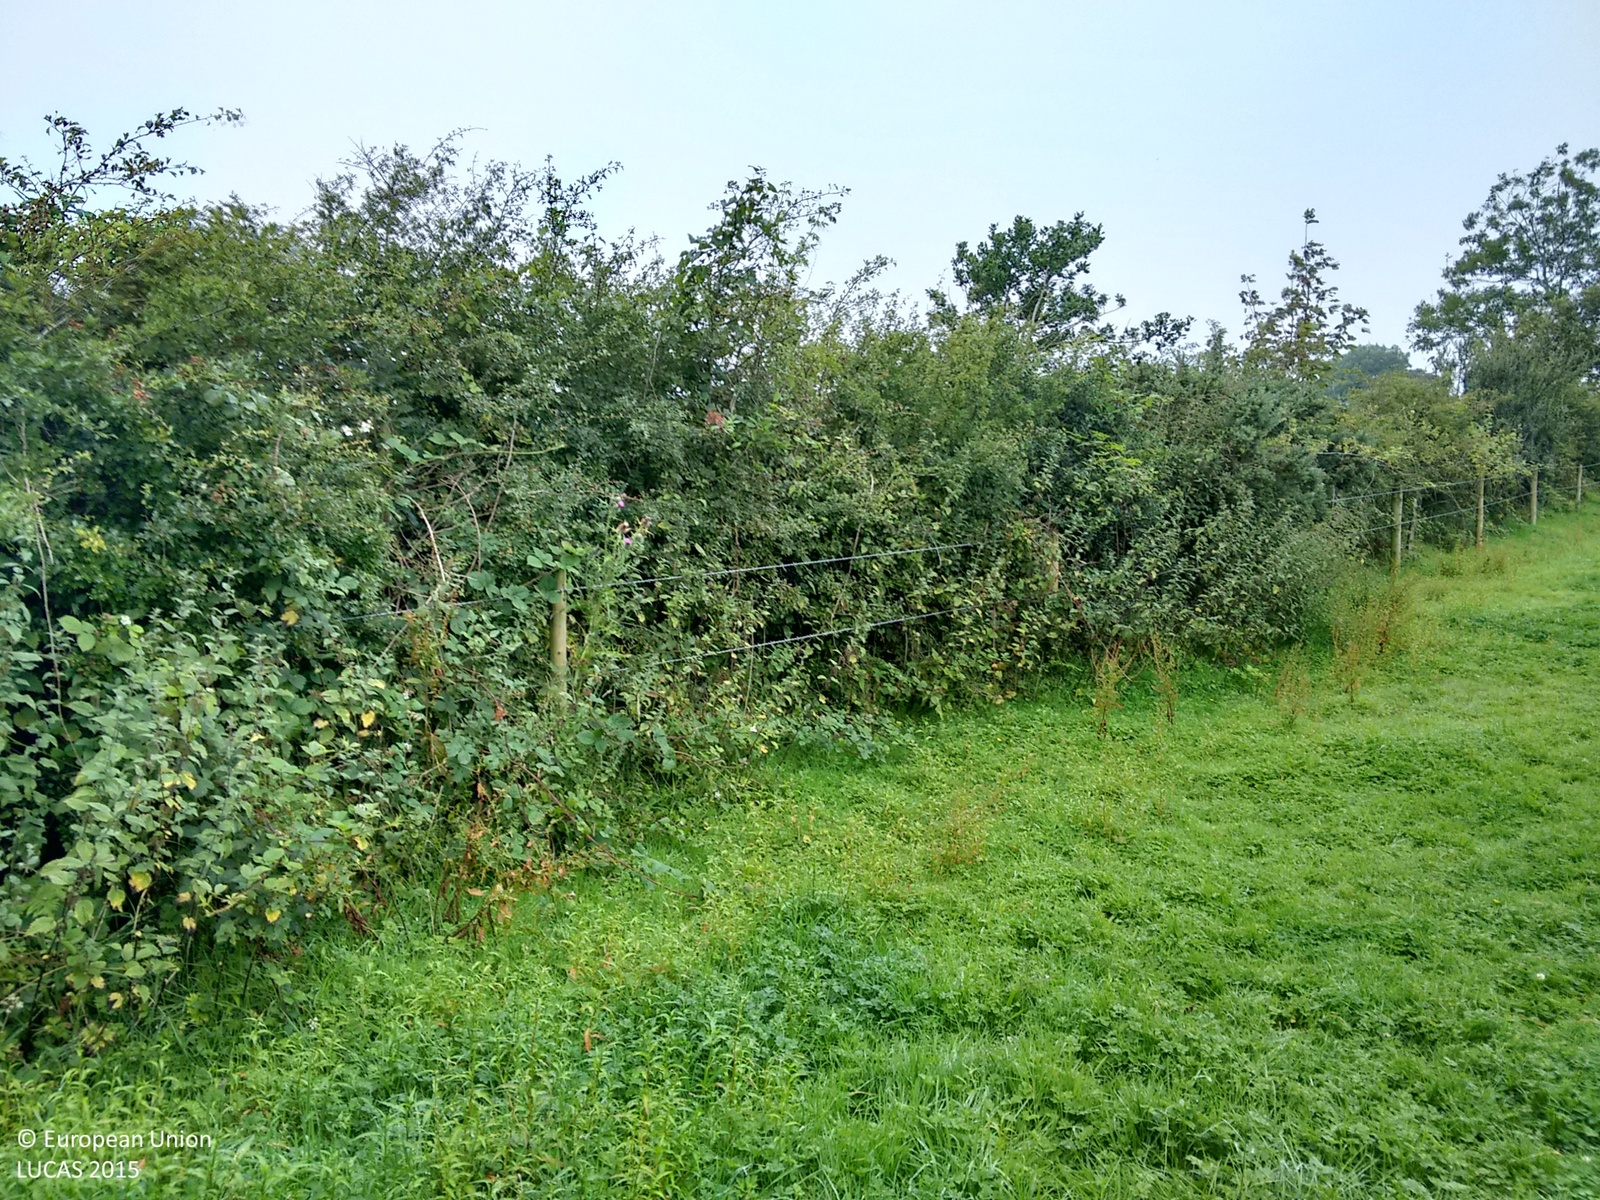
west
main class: Grassland
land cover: Grassland without tree/shrub cover
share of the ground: > 75 %
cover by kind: herbaceous plants 100 %
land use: Agriculture (excluding fallow land and kitchen gardens)
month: August
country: GB
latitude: 51.7557
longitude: -4.6390
